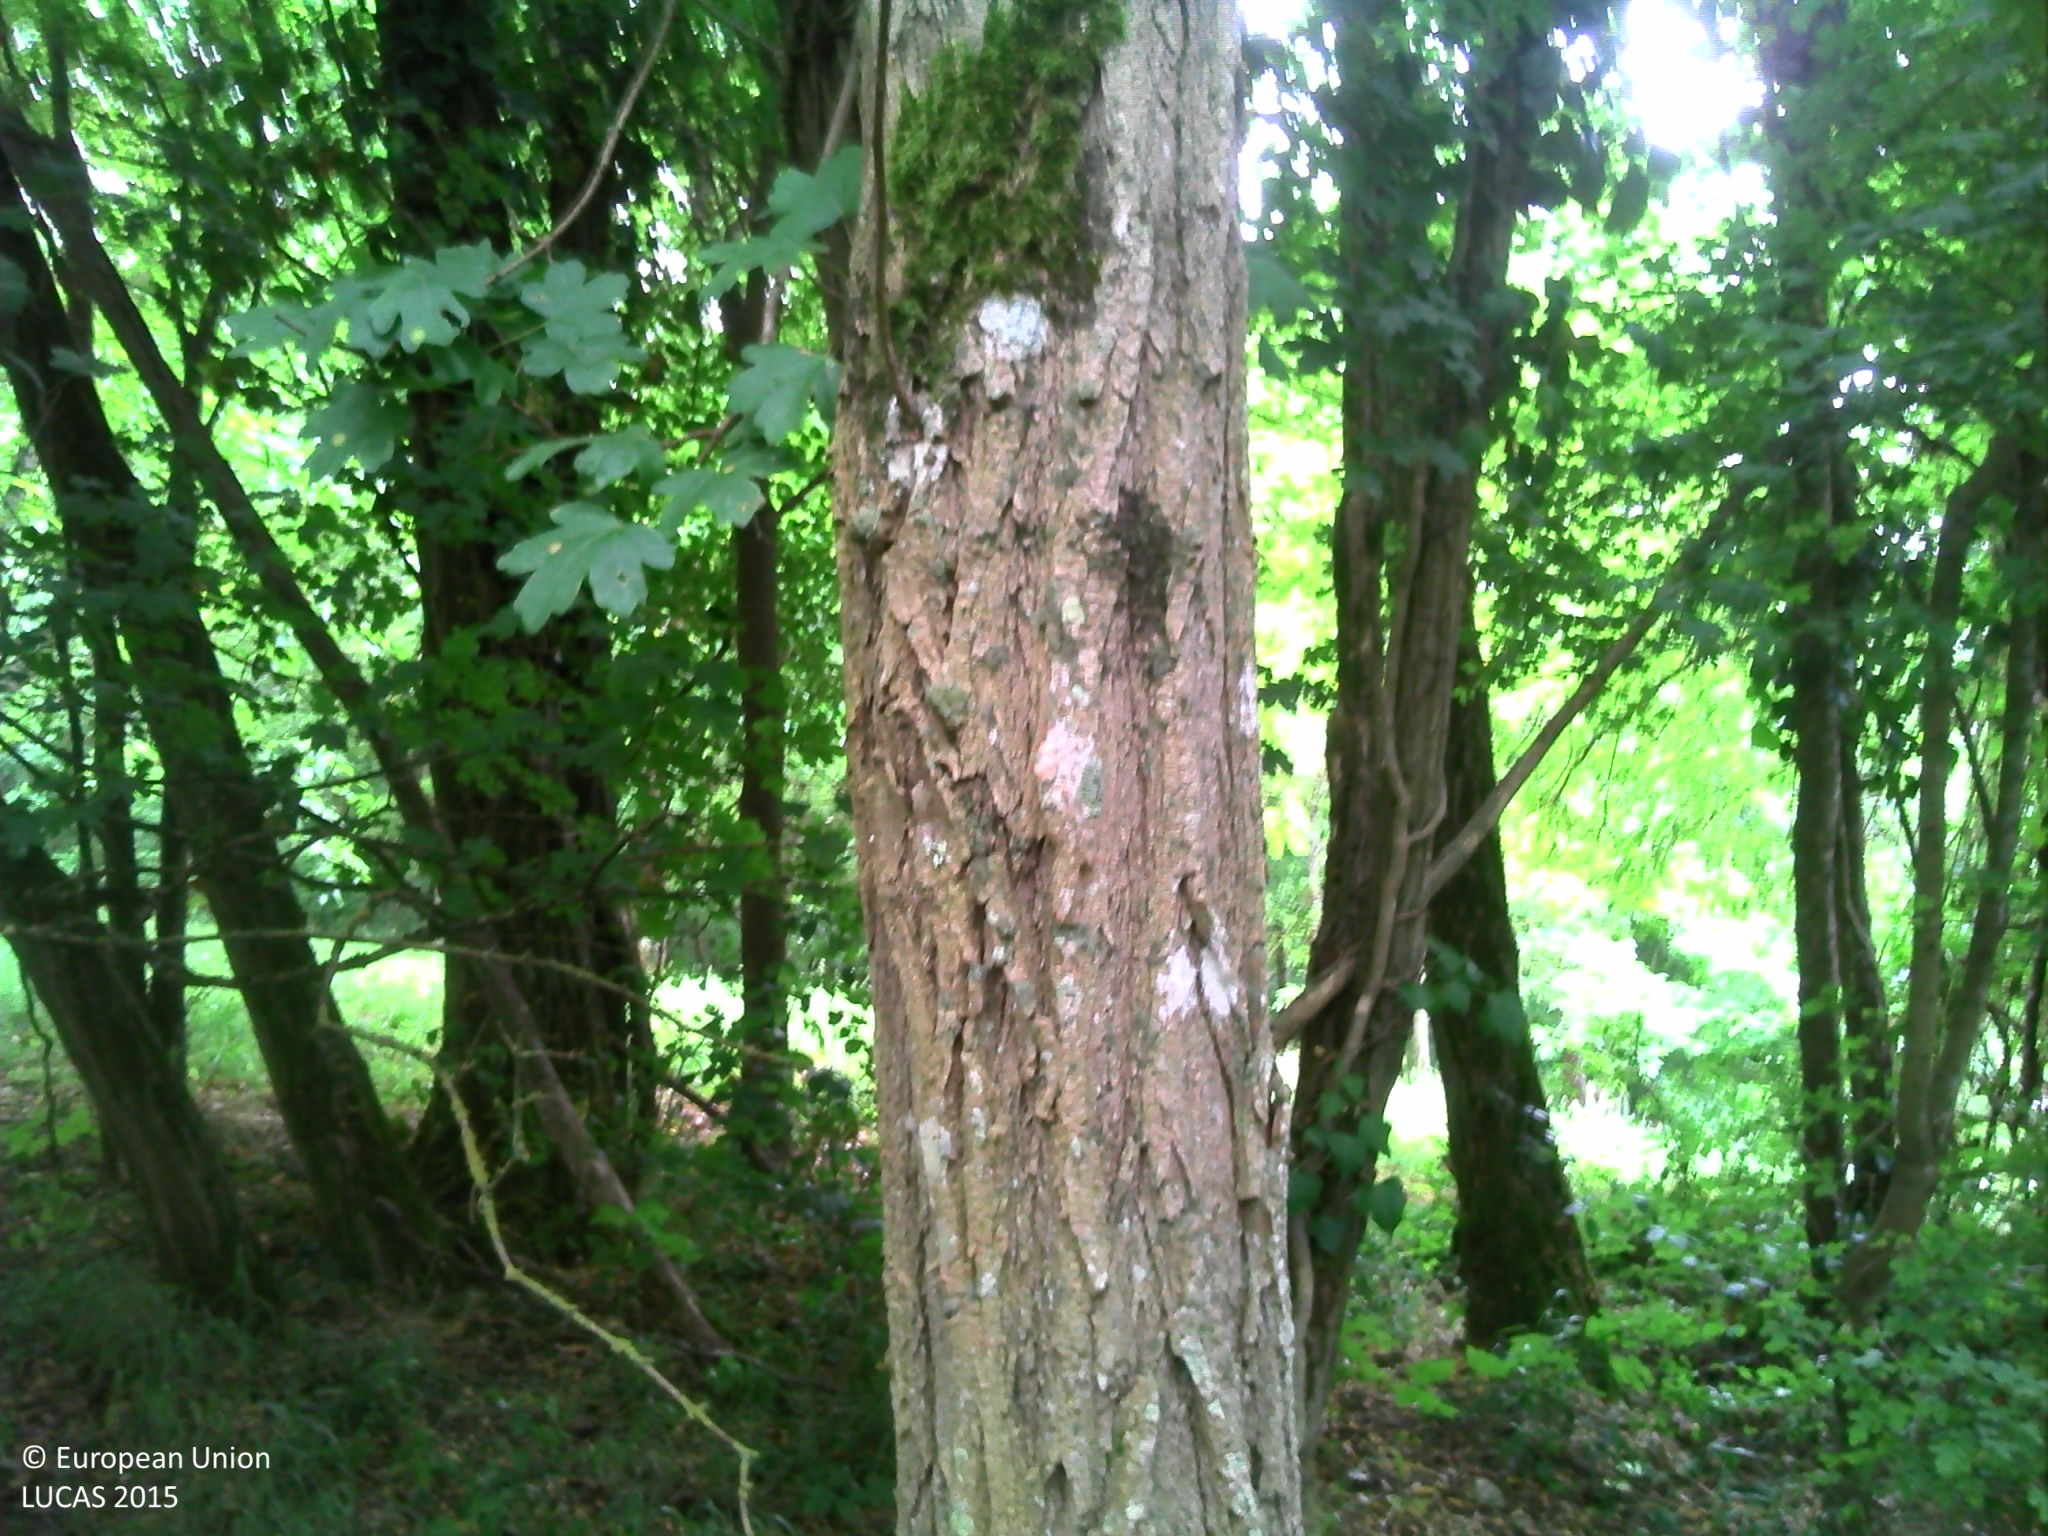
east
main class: Woodland
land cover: Broadleaved woodland
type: mesophytic deciduous forest
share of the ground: > 75 %
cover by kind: broadleaved forest trees 75 %, shrubs 10 %, herbaceous plants 10 %, lichens and mosses 5 %
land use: Forestry
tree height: > 5 m
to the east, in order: Broadleaved woodland; Shrubland with sparse tree cover; Tracks
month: July
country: FR
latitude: 47.3110
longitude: 0.3614
